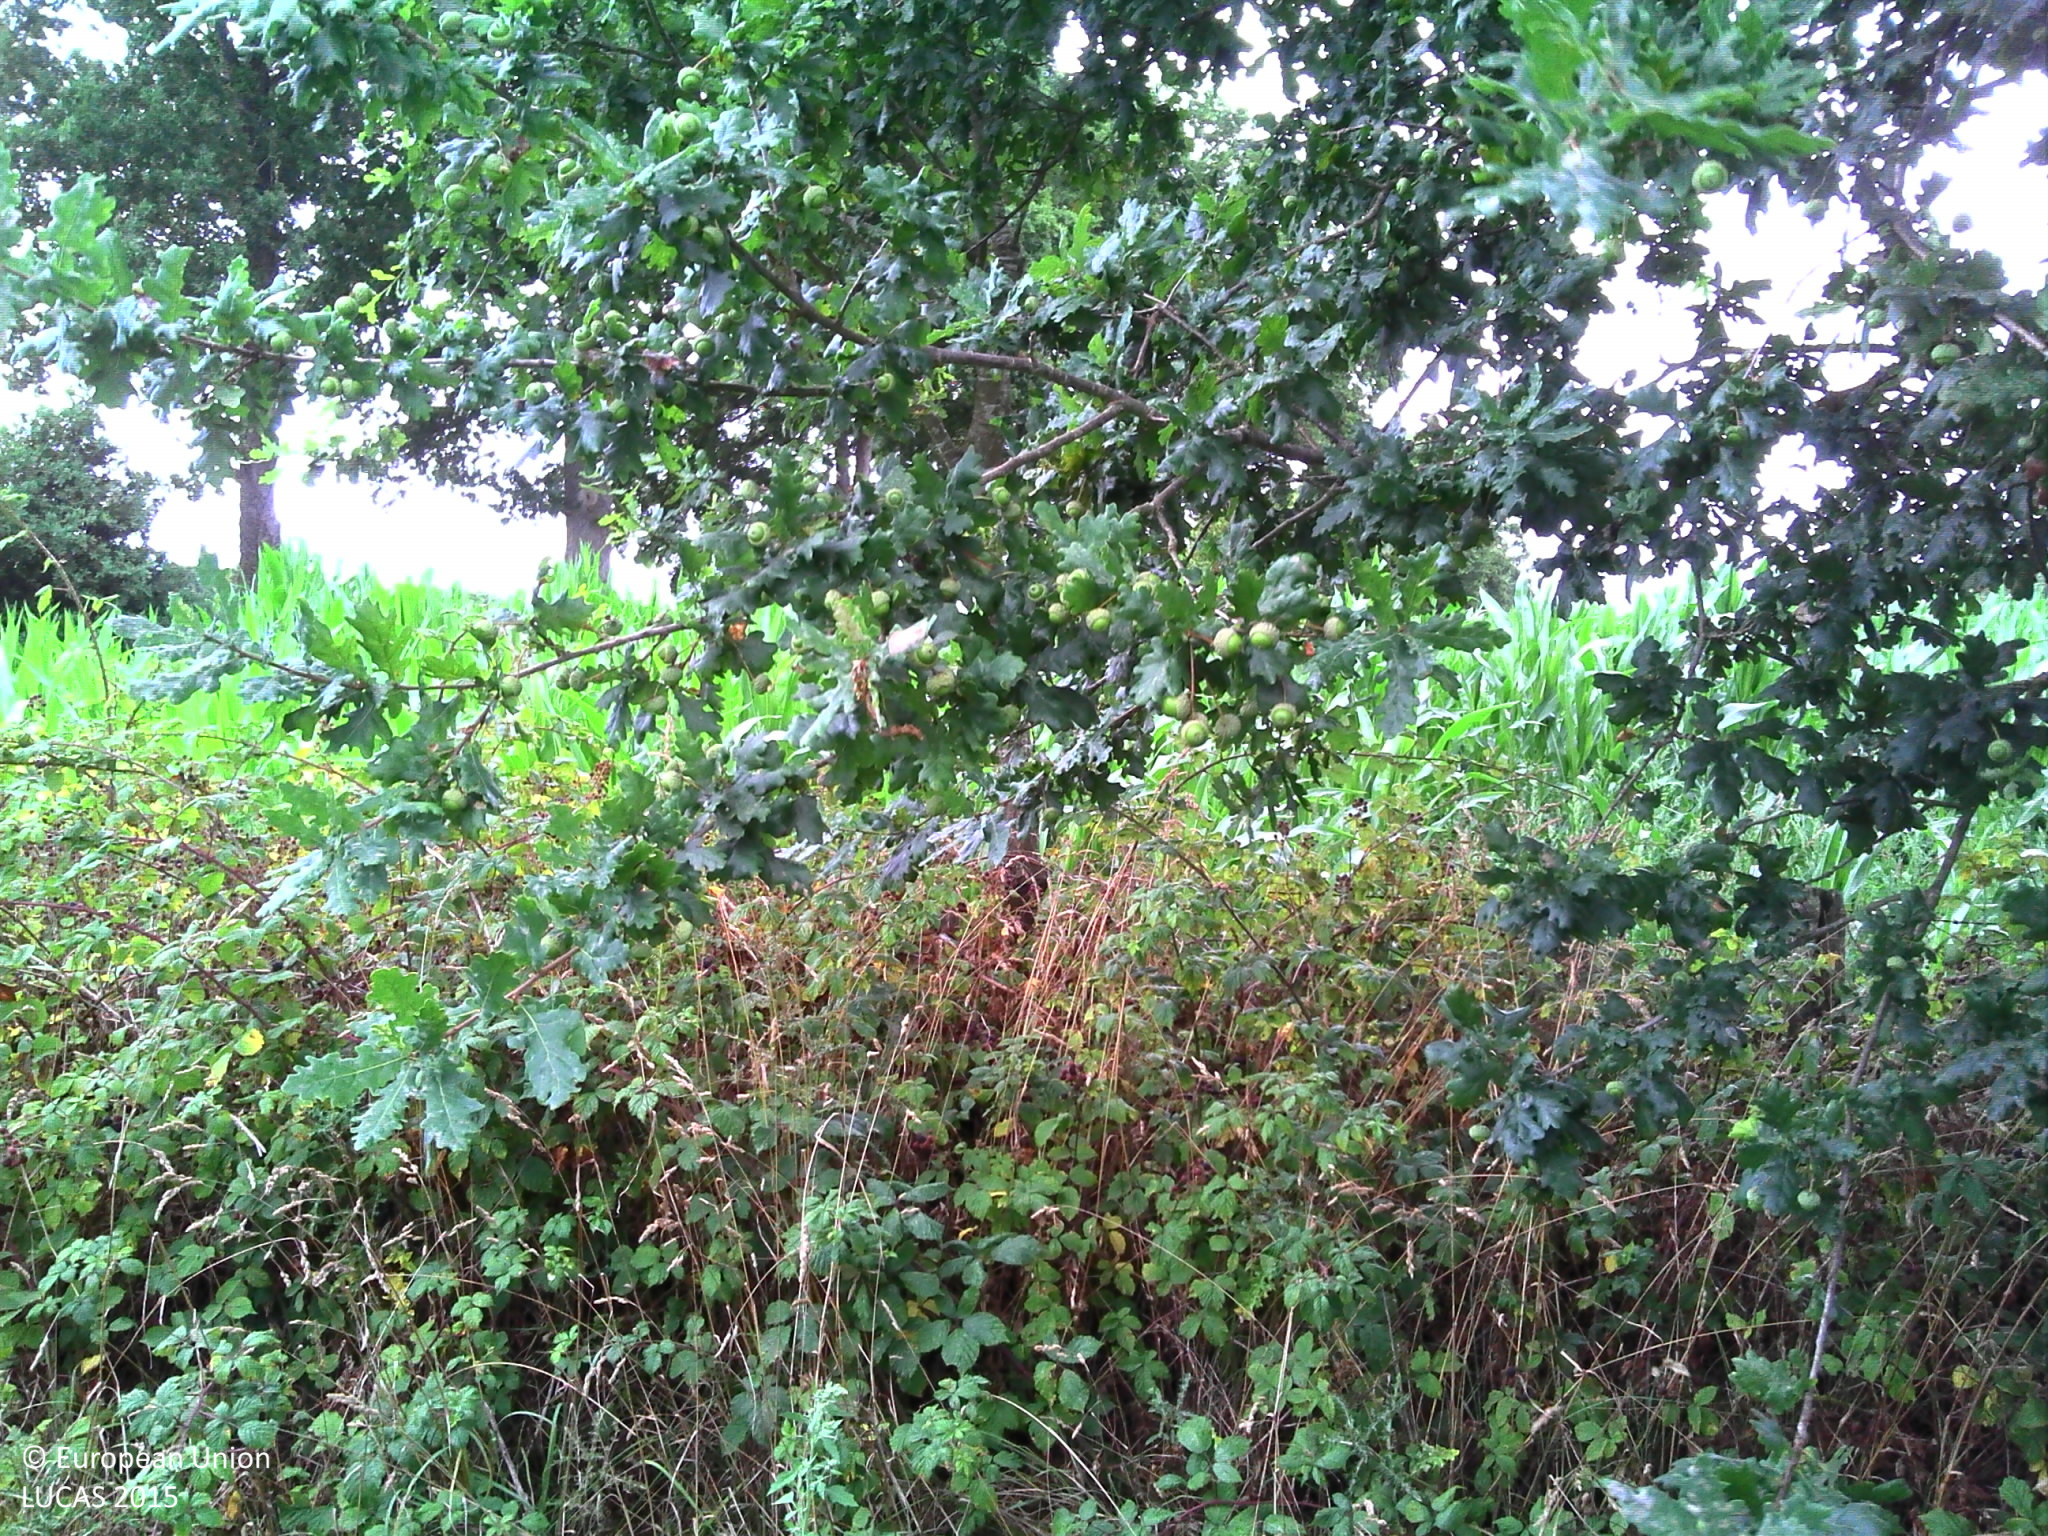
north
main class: Cropland
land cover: Maize
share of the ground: 50 - 75 %
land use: Agriculture (excluding fallow land and kitchen gardens)
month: July
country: FR
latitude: 47.4974
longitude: -1.9562
